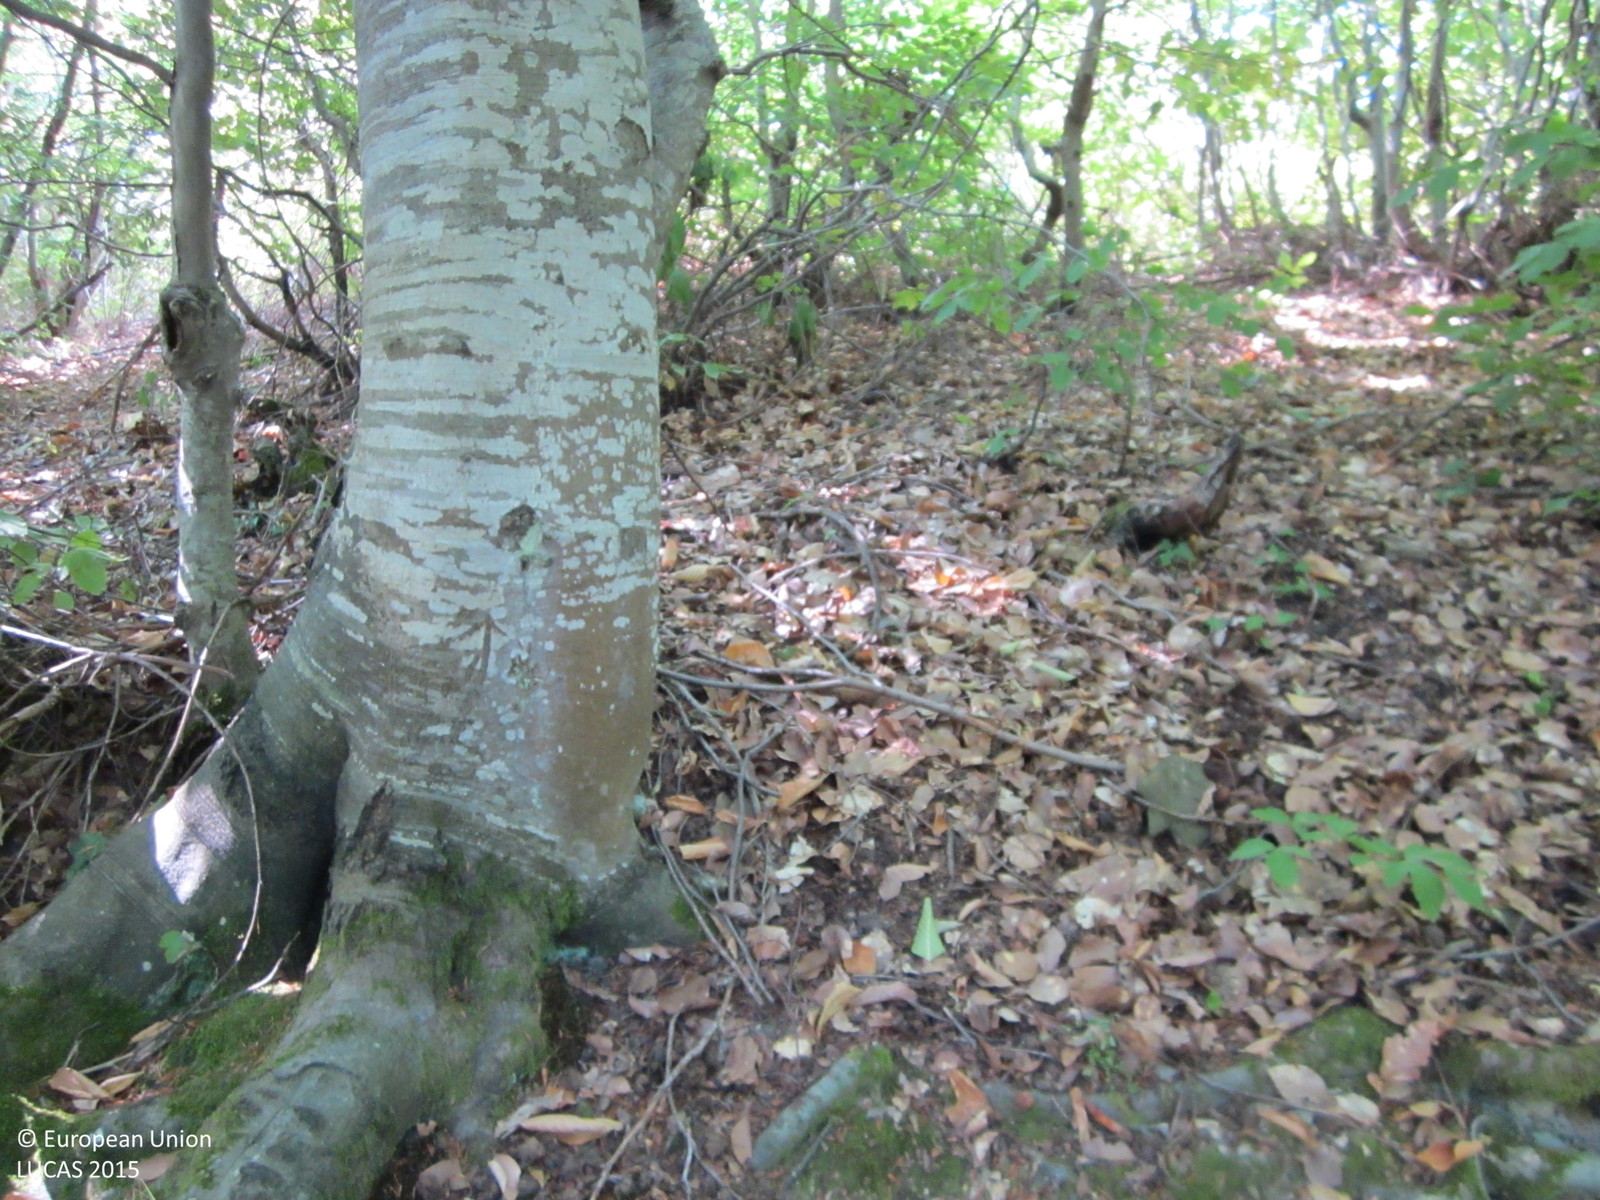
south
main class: Woodland
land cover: Broadleaved woodland
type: thermophilous deciduous forest
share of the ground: > 75 %
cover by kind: broadleaved forest trees 90 %, lichens and mosses 5 %, unconsolidated bare surface 5 %
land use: Forestry
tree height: > 5 m
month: August
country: BG
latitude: 42.0890
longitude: 27.7330
